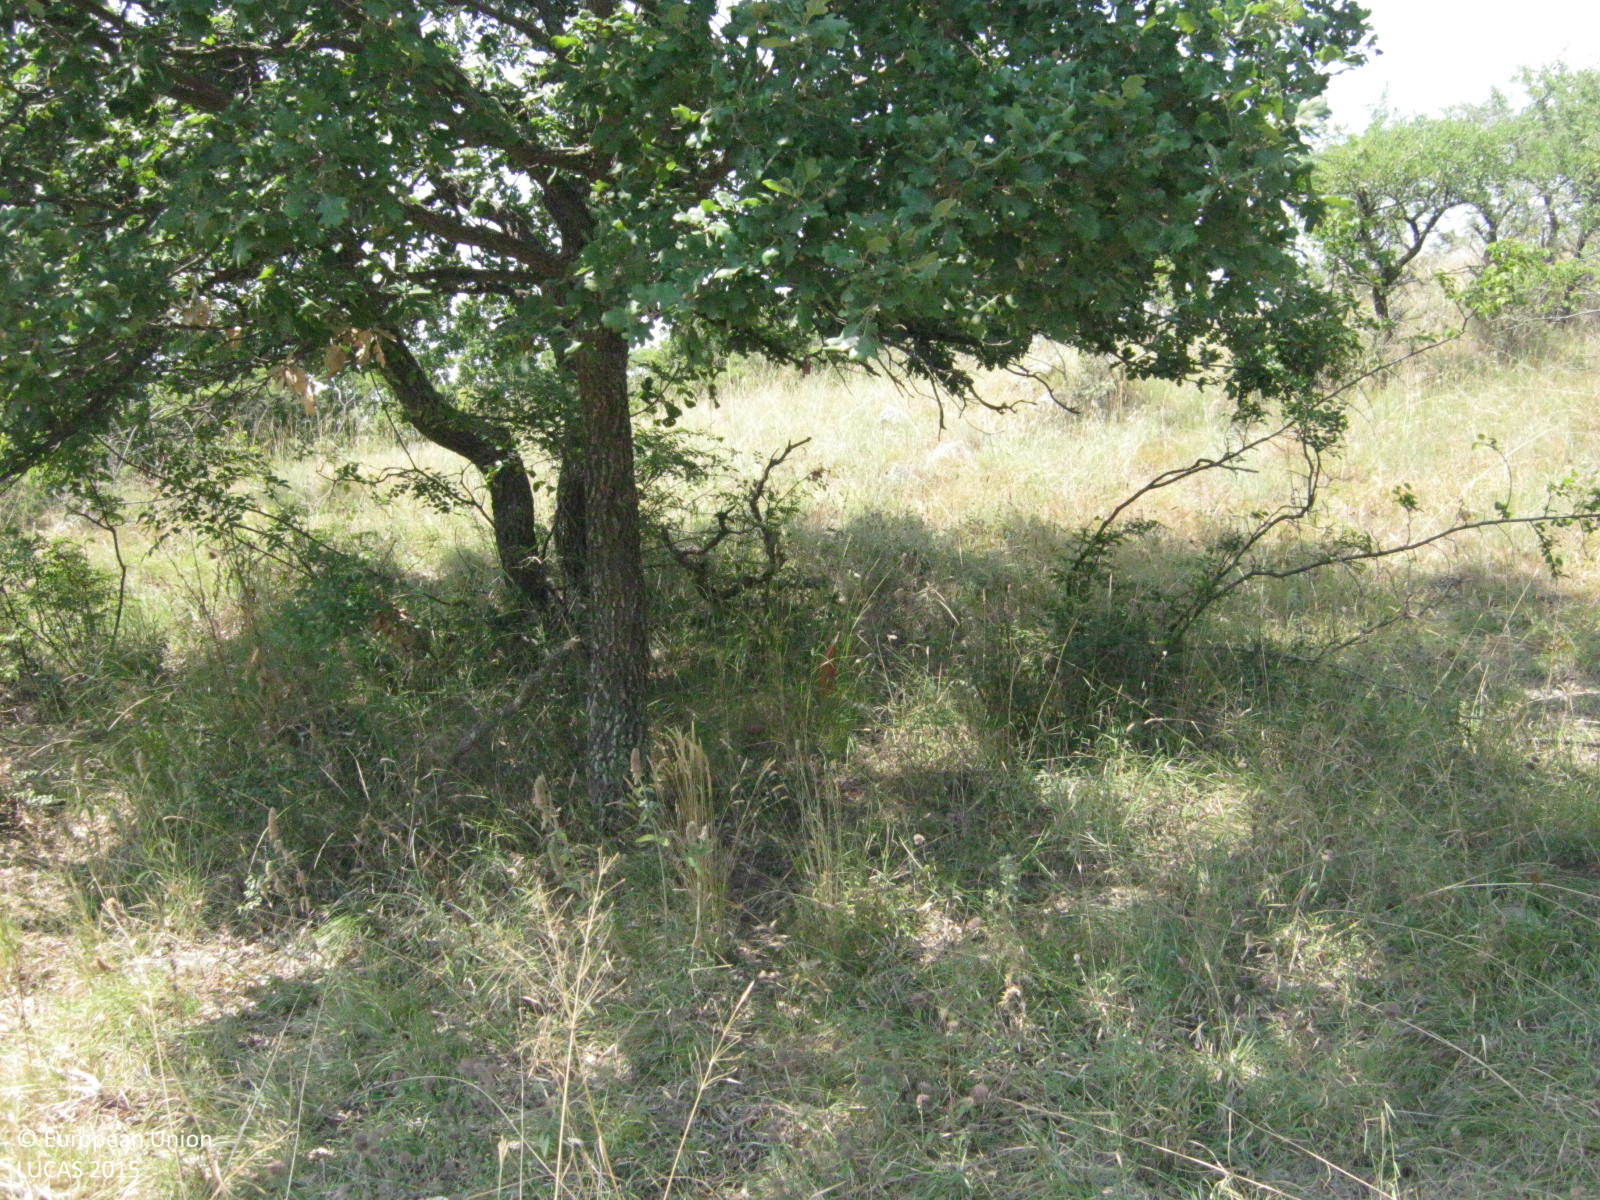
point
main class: Woodland
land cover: Broadleaved woodland
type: thermophilous deciduous forest
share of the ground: 10 - 25 %
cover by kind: herbaceous plants 70 %, broadleaved forest trees 20 %, shrubs 10 %
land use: Semi-natural and natural areas not in use
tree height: > 5 m
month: August
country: GR
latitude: 40.9360
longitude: 22.9927
